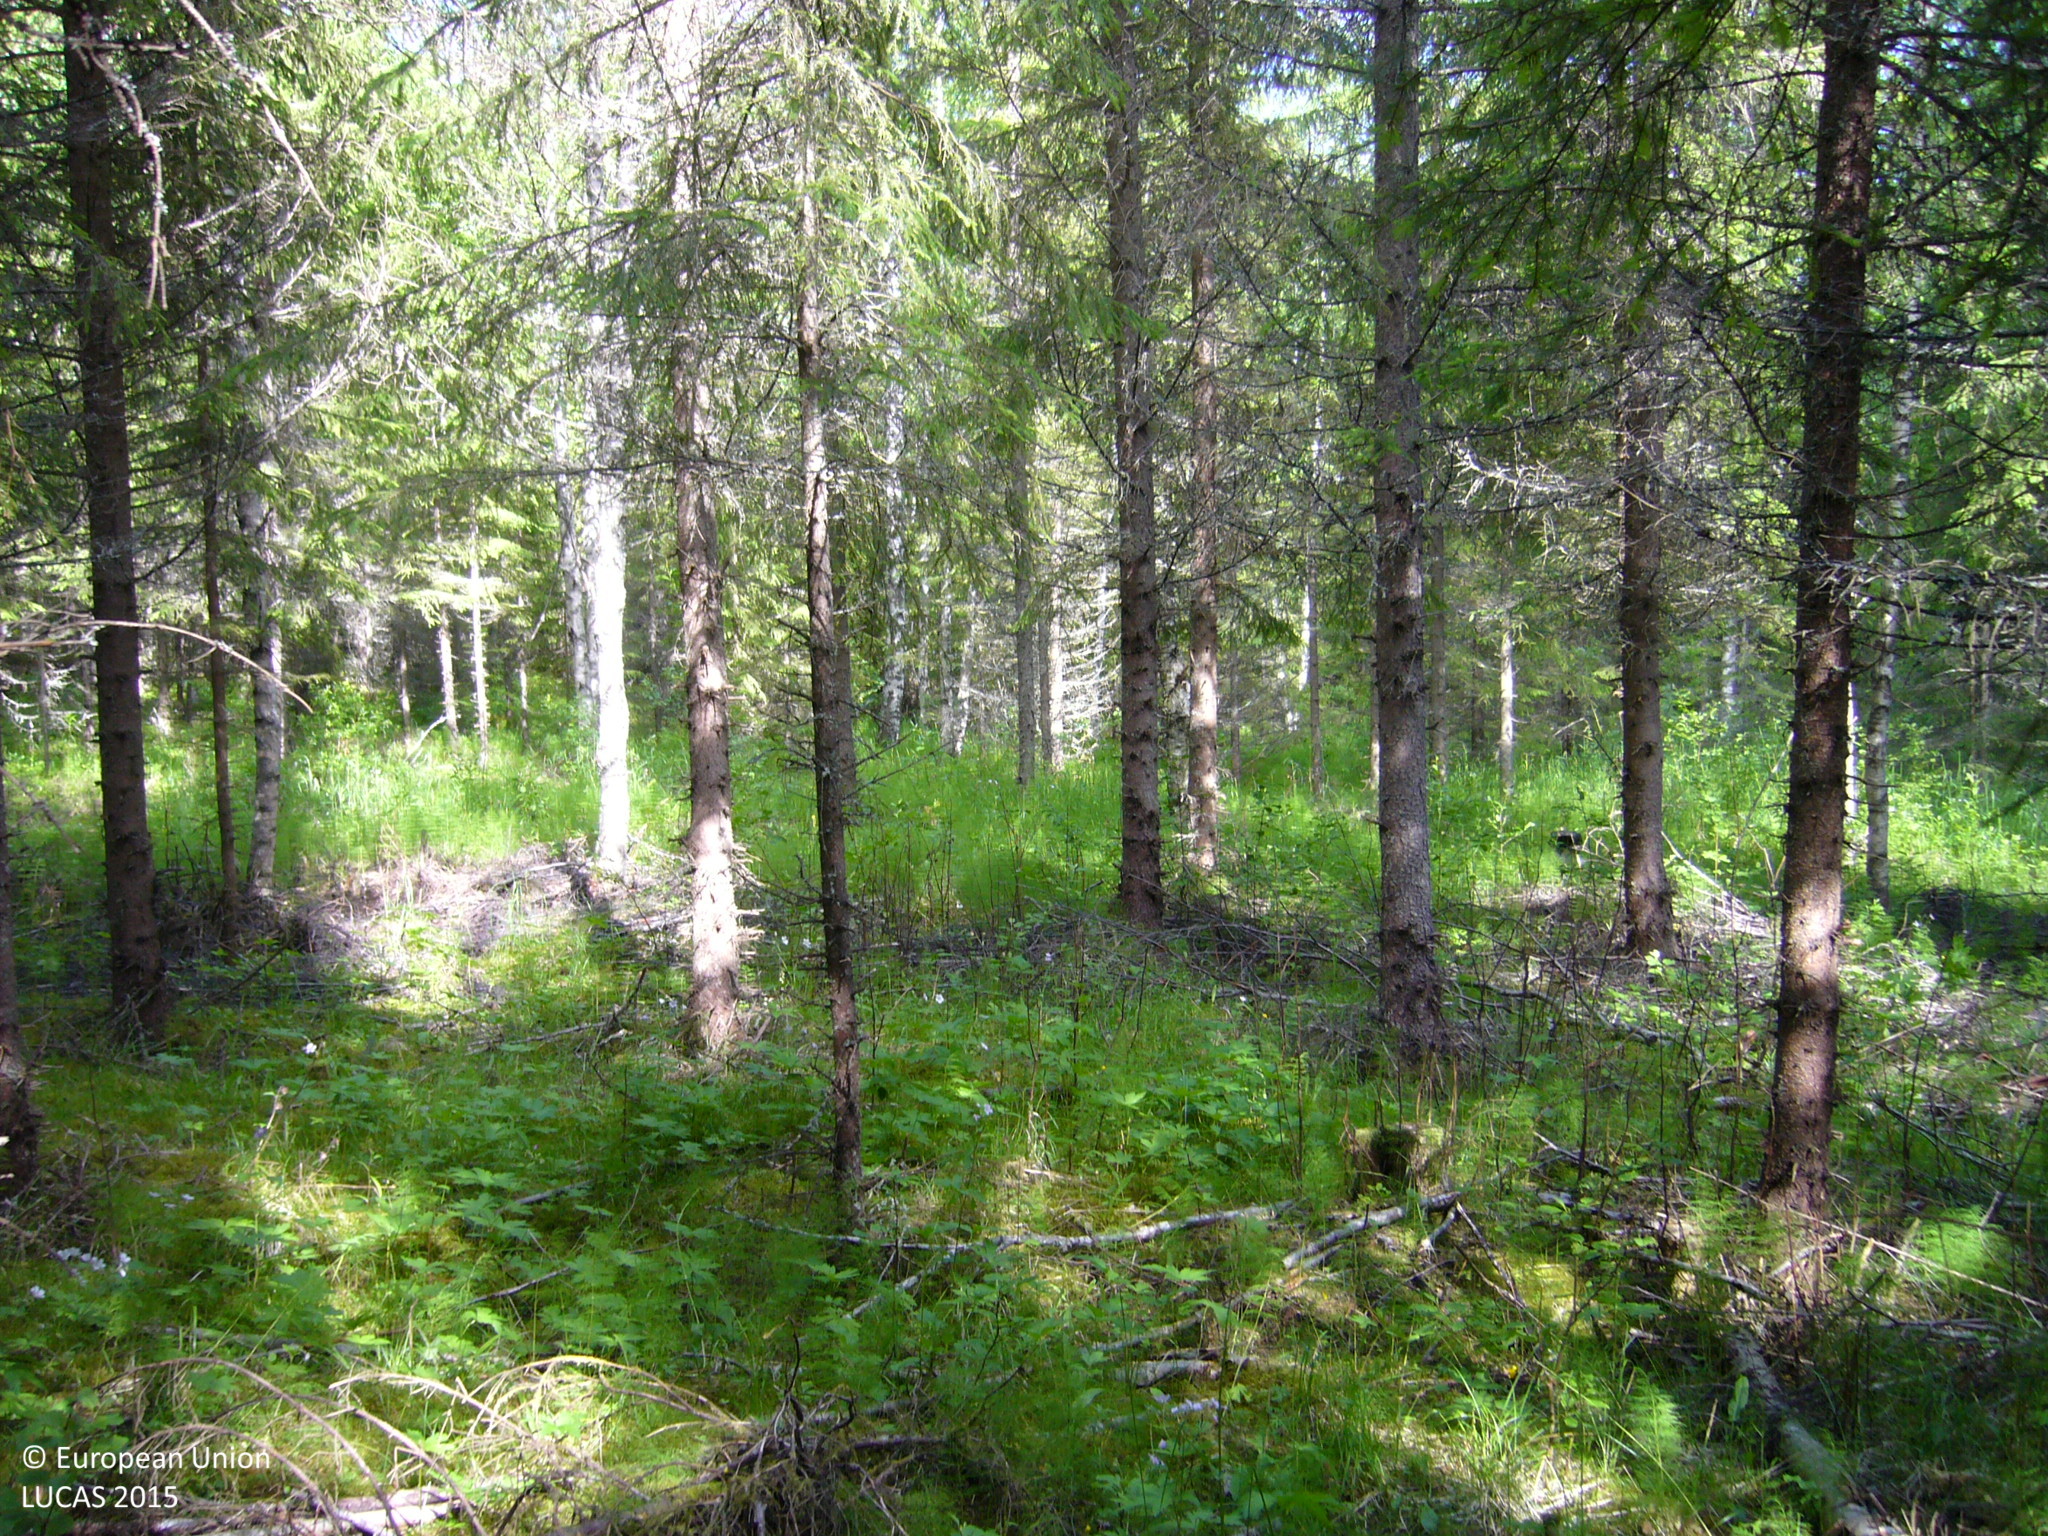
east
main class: Woodland
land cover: Spruce dominated coniferous woodland
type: boreal forest
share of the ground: > 75 %
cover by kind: coniferous forest trees 85 %, shrubs 10 %, broadleaved forest trees 5 %
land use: Forestry
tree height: > 5 m
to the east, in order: Spruce dominated coniferous woodland; Spruce dominated mixed woodland; Tracks; Spruce dominated mixed woodland; Broadleaved woodland; Ditches and canals; Broadleaved woodland
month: July
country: FI
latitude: 63.5007
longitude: 26.2096
